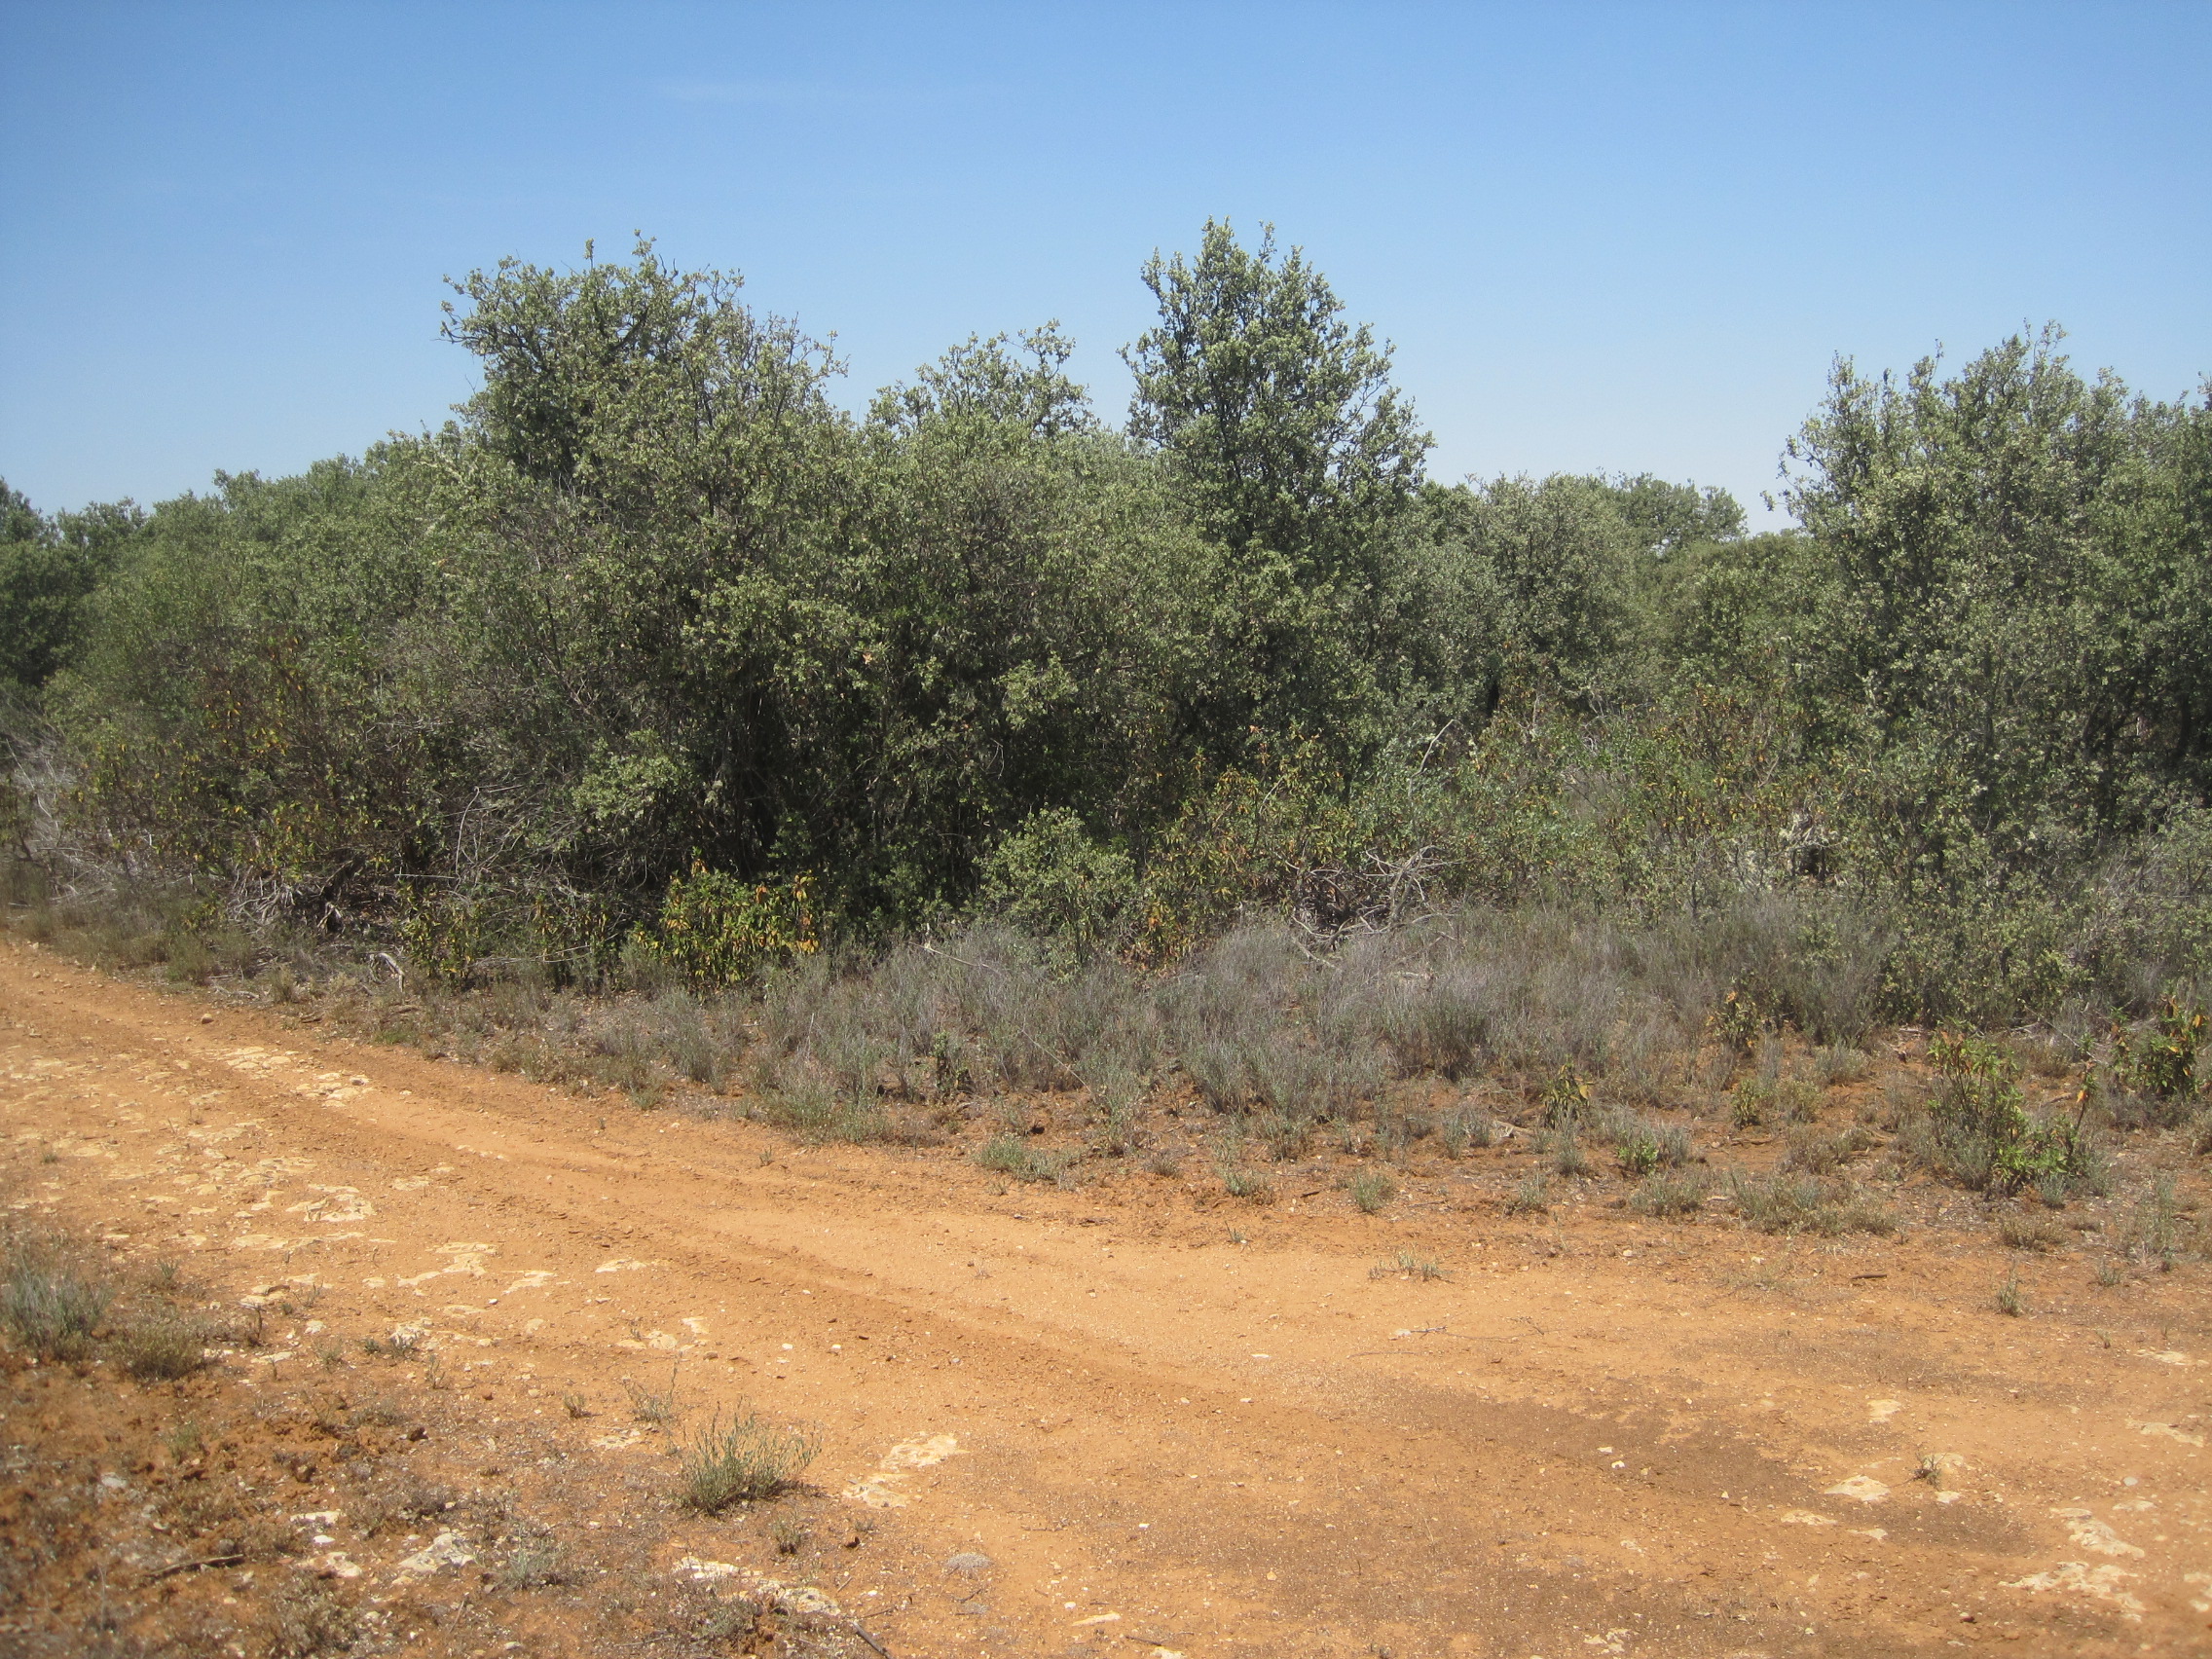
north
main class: Woodland
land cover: Broadleaved woodland
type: thermophilous deciduous forest
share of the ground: > 75 %
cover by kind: broadleaved forest trees 80 %, herbaceous plants 20 %
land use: Forestry
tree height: > 5 m
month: July
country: ES
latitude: 41.7460
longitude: -5.1454
